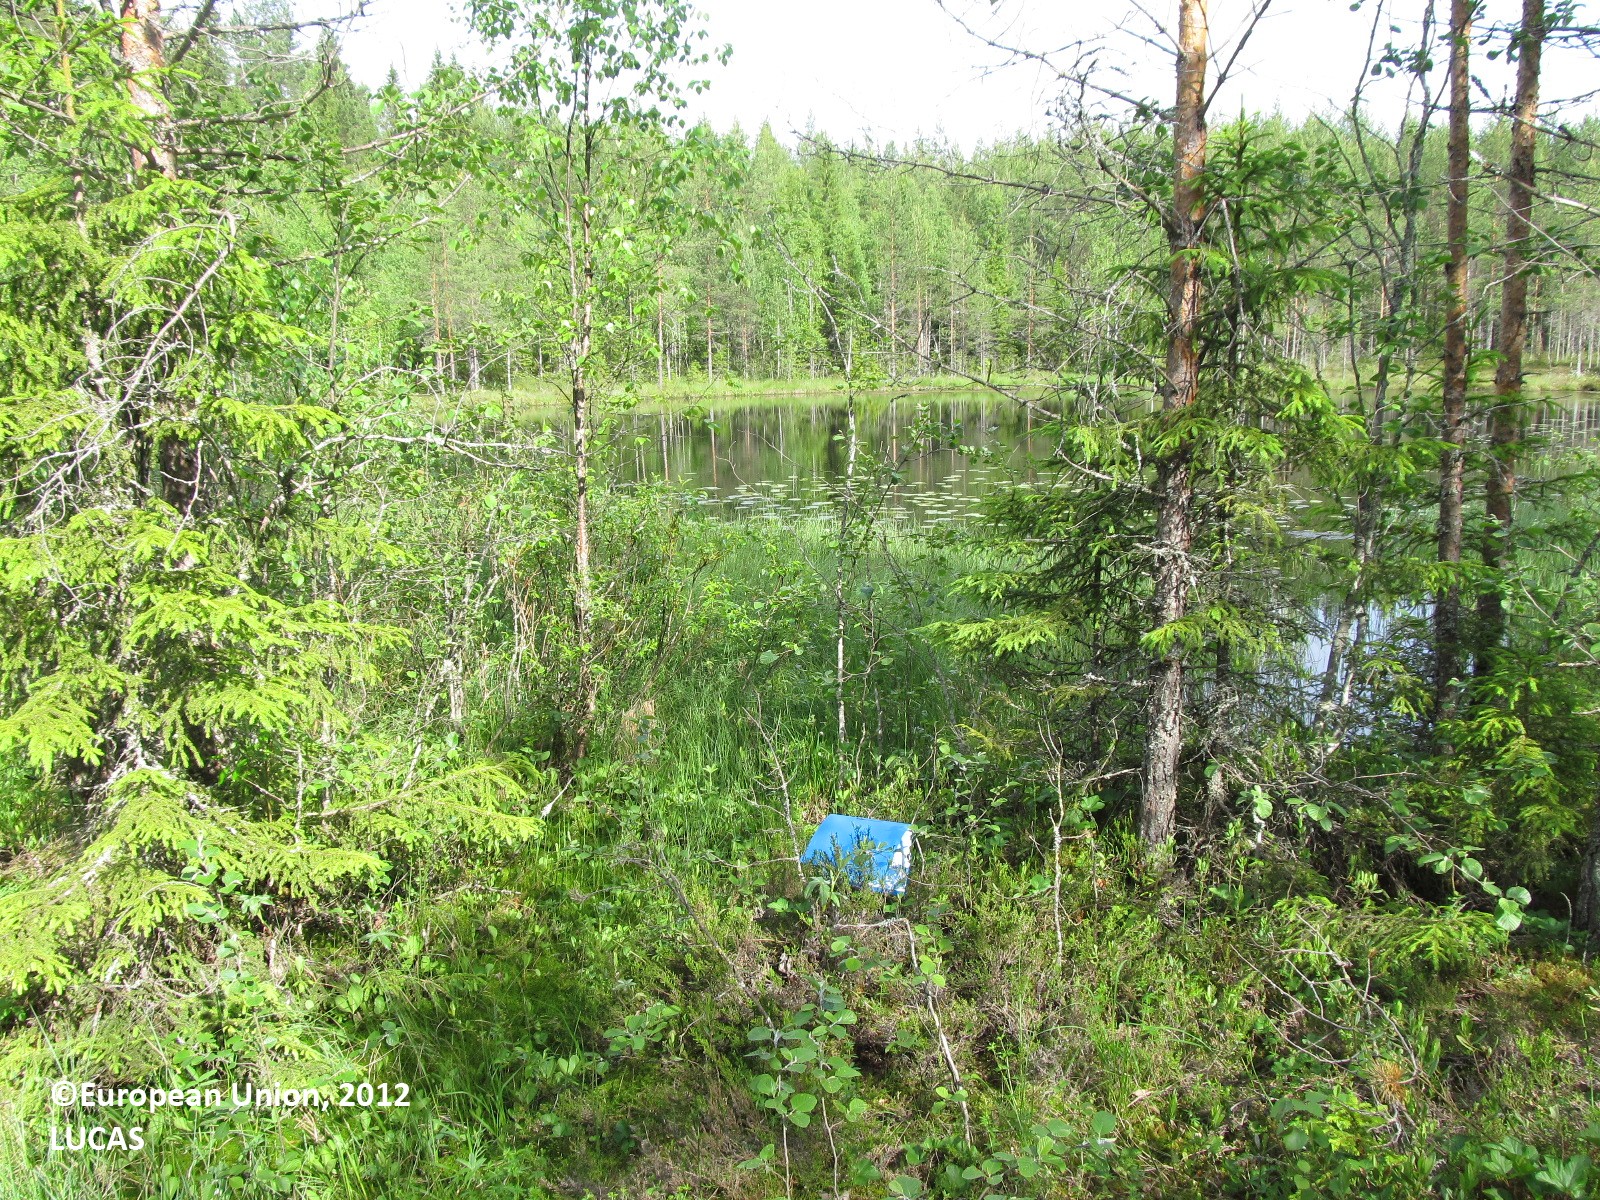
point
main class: Woodland
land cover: Pine dominated mixed woodland
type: boreal forest
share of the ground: 50 - 75 %
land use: Semi-natural and natural areas not in use
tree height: > 5 m
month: June
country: FI
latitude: 62.9563
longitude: 28.9612
